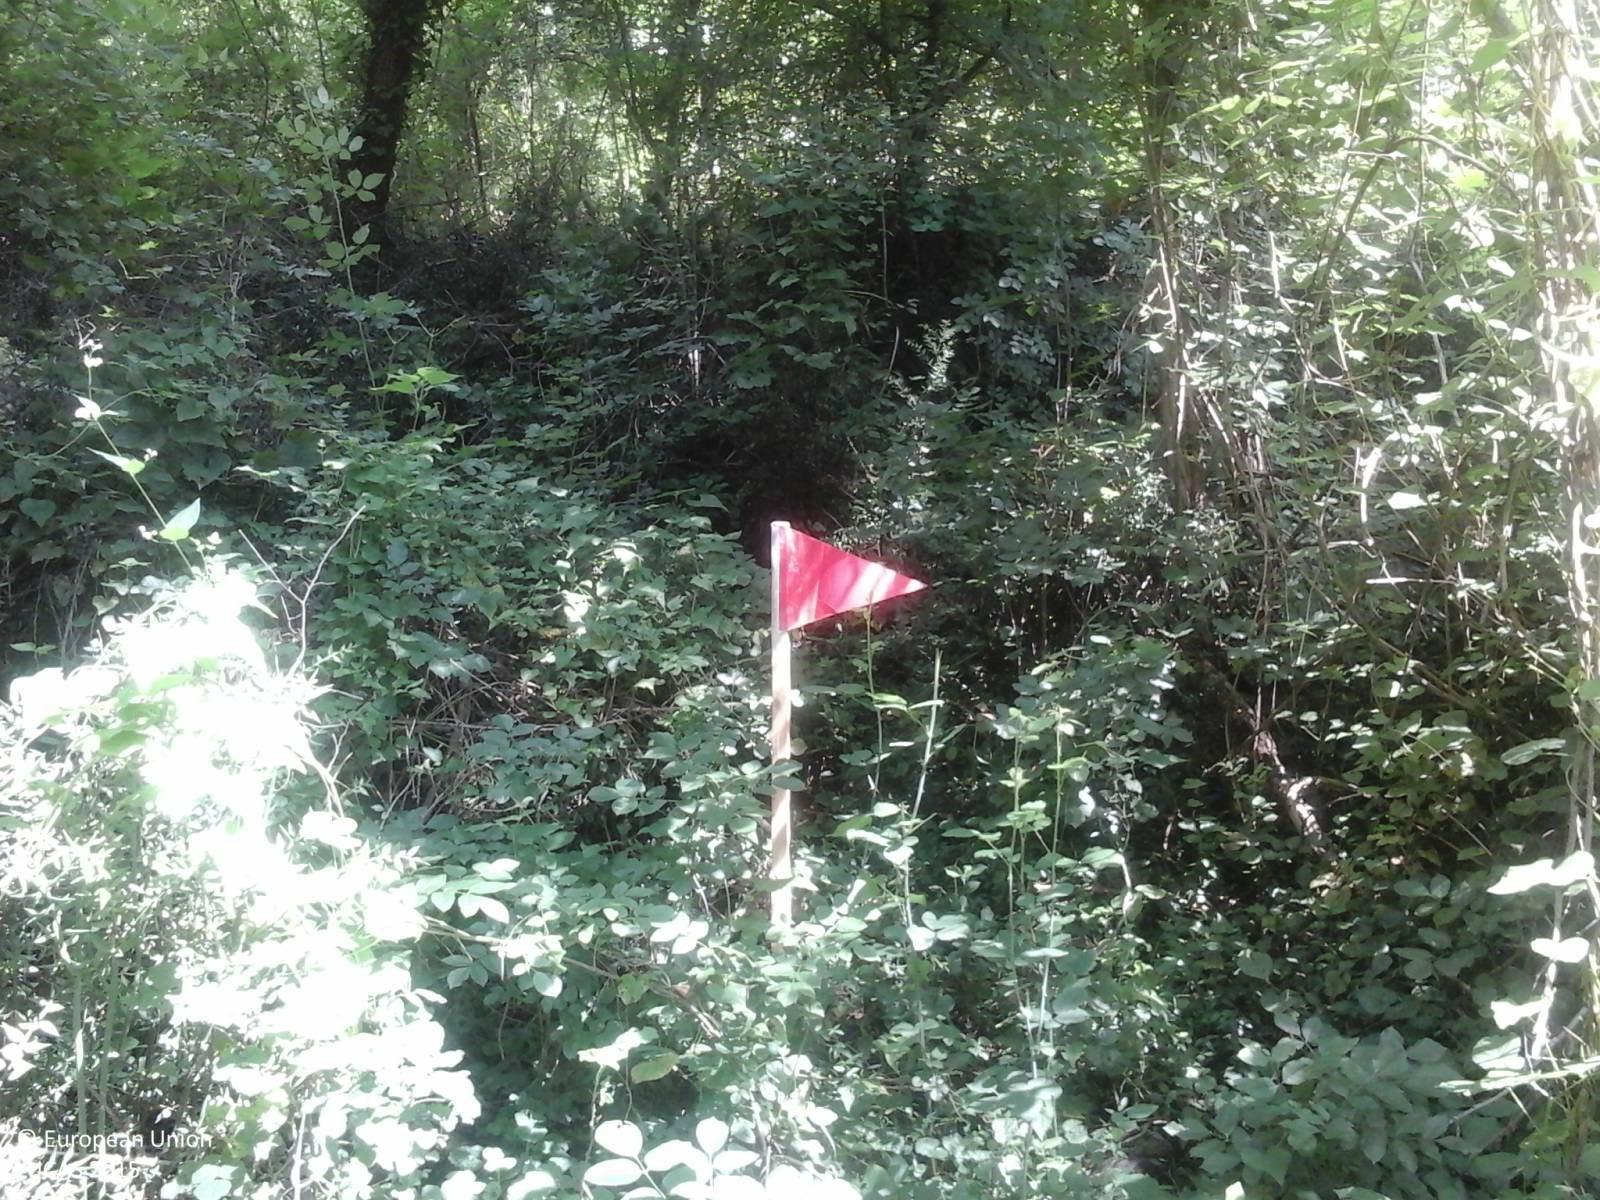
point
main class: Woodland
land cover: Broadleaved woodland
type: exotic forest
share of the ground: > 75 %
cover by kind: broadleaved forest trees 80 %, shrubs 20 %
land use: Forestry
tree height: > 5 m
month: June
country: IT
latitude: 46.0861
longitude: 12.5704
